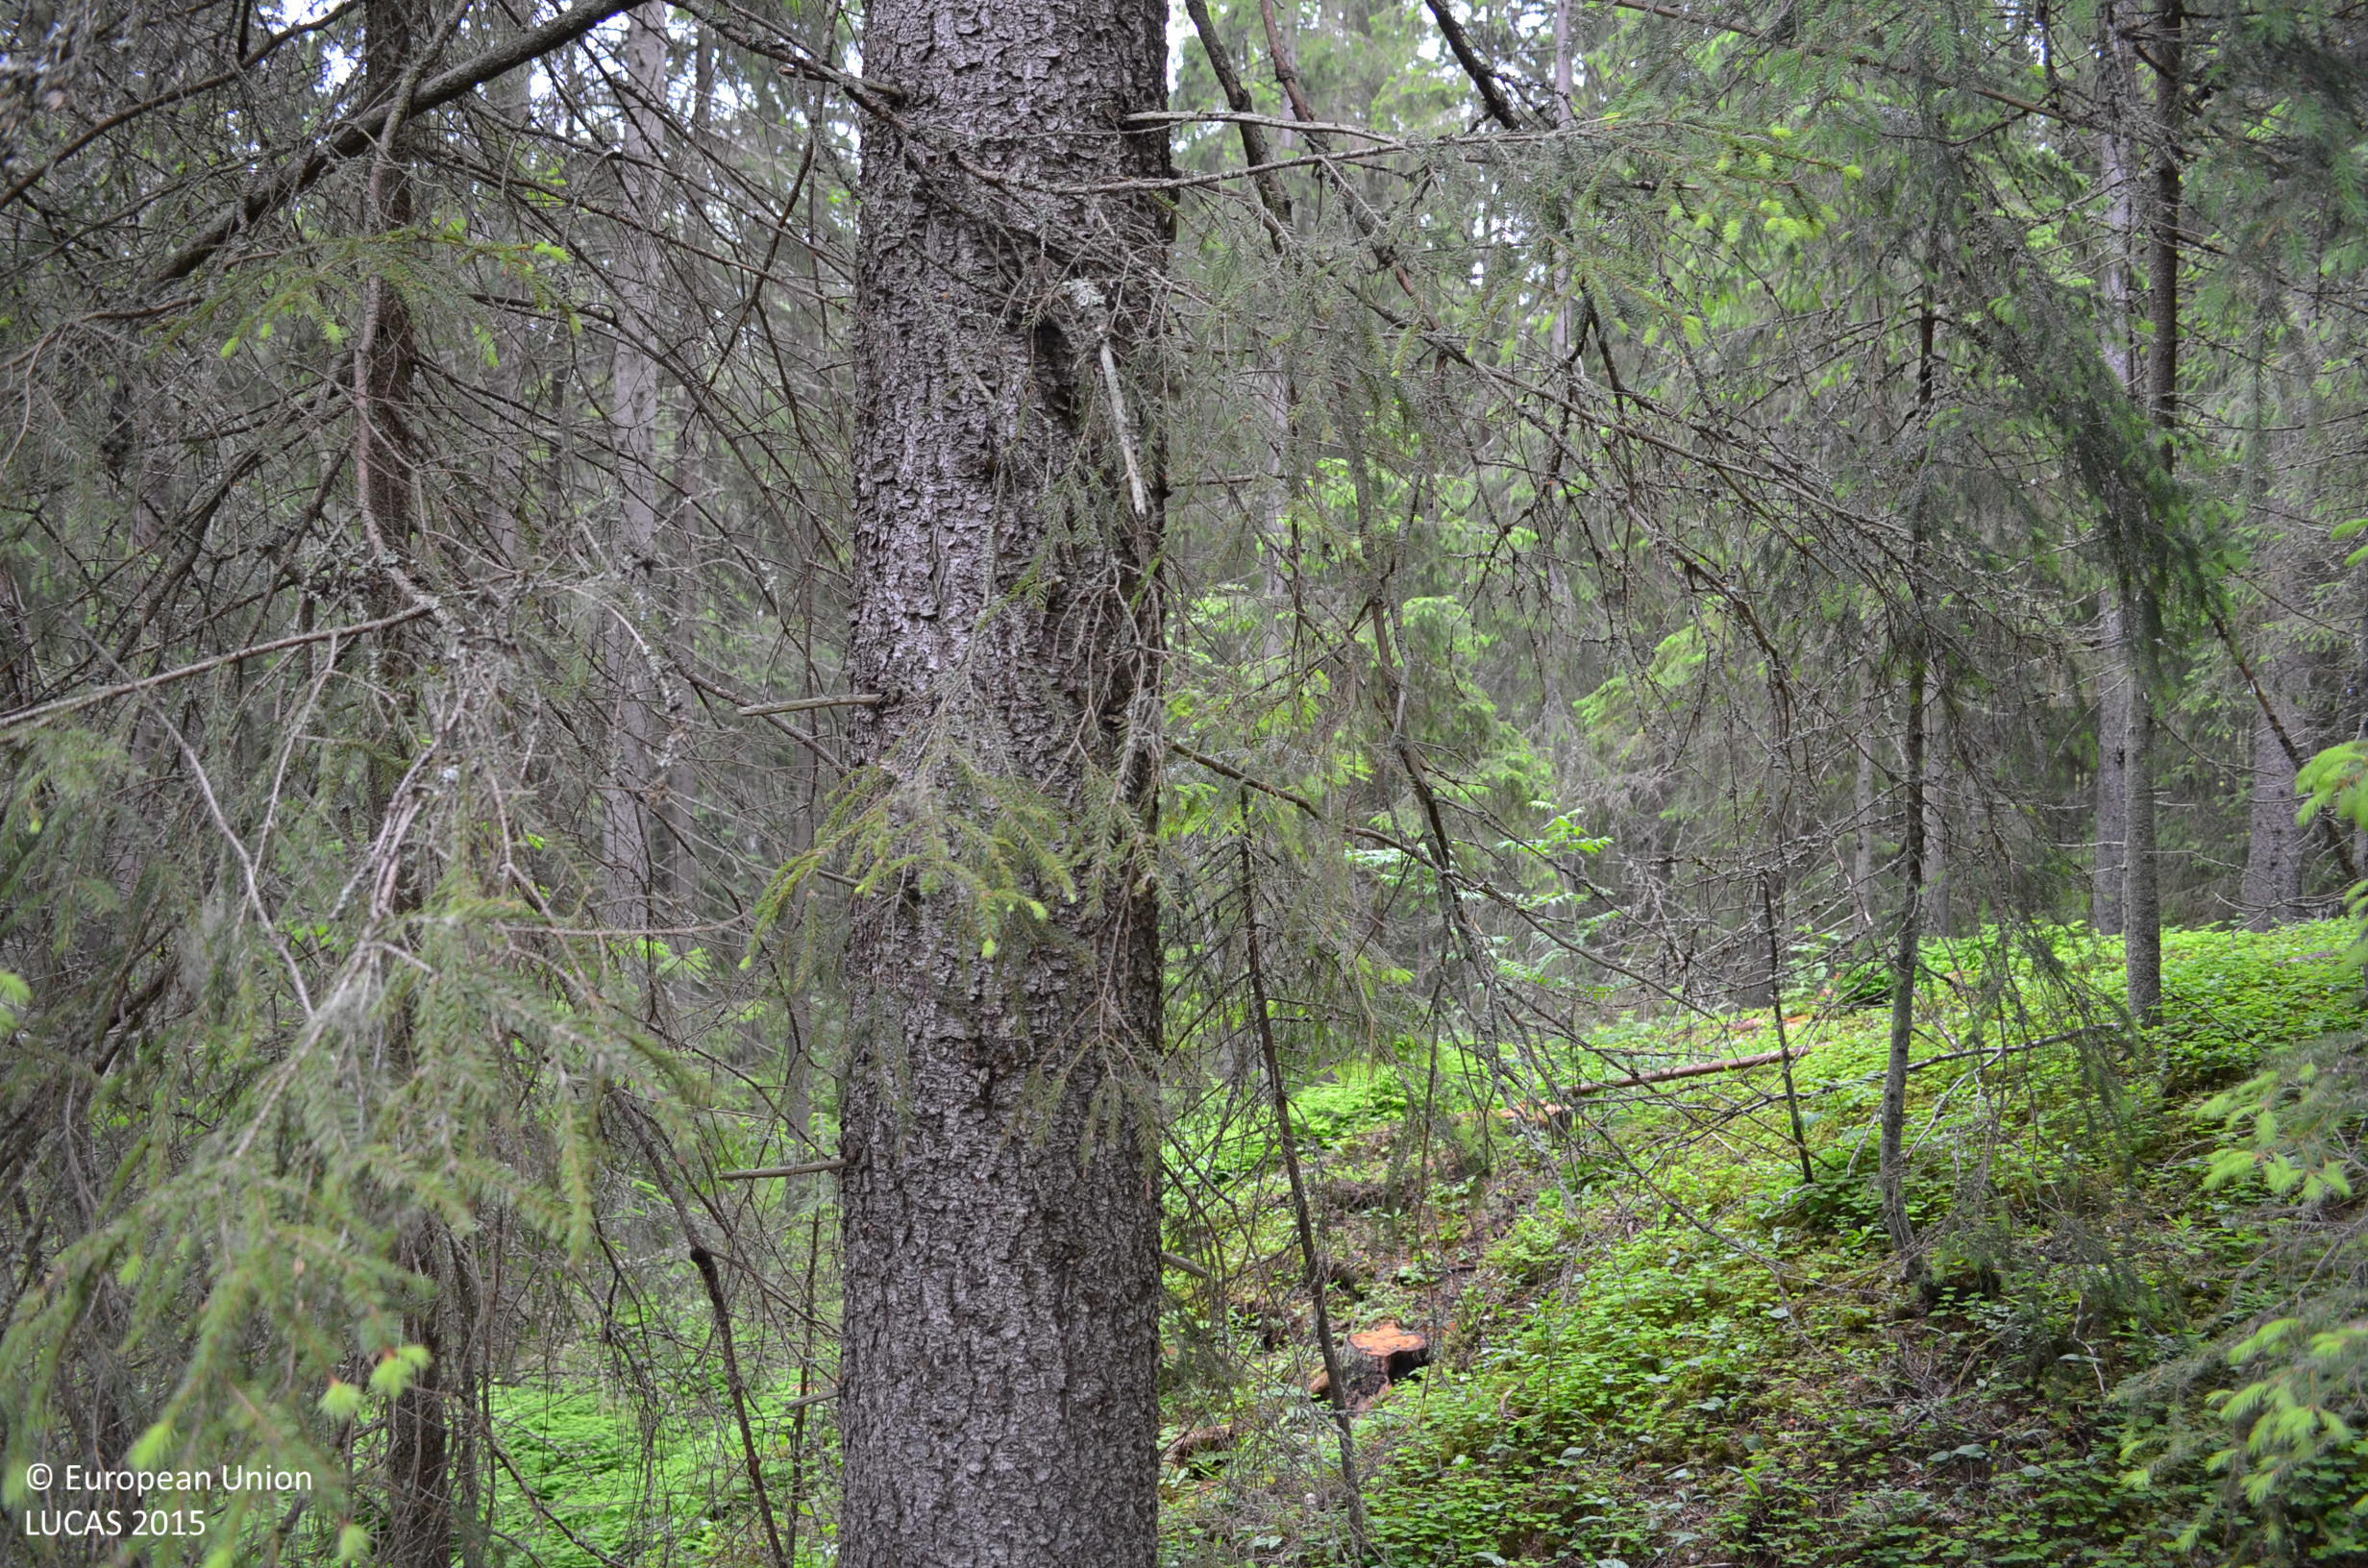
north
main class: Woodland
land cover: Spruce dominated coniferous woodland
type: boreal forest
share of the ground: > 75 %
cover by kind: coniferous forest trees 75 %, broadleaved forest trees 10 %, shrubs 5 %, herbaceous plants 5 %, lichens and mosses 5 %
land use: Forestry
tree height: > 5 m
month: June
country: FI
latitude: 61.7390
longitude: 23.1537
